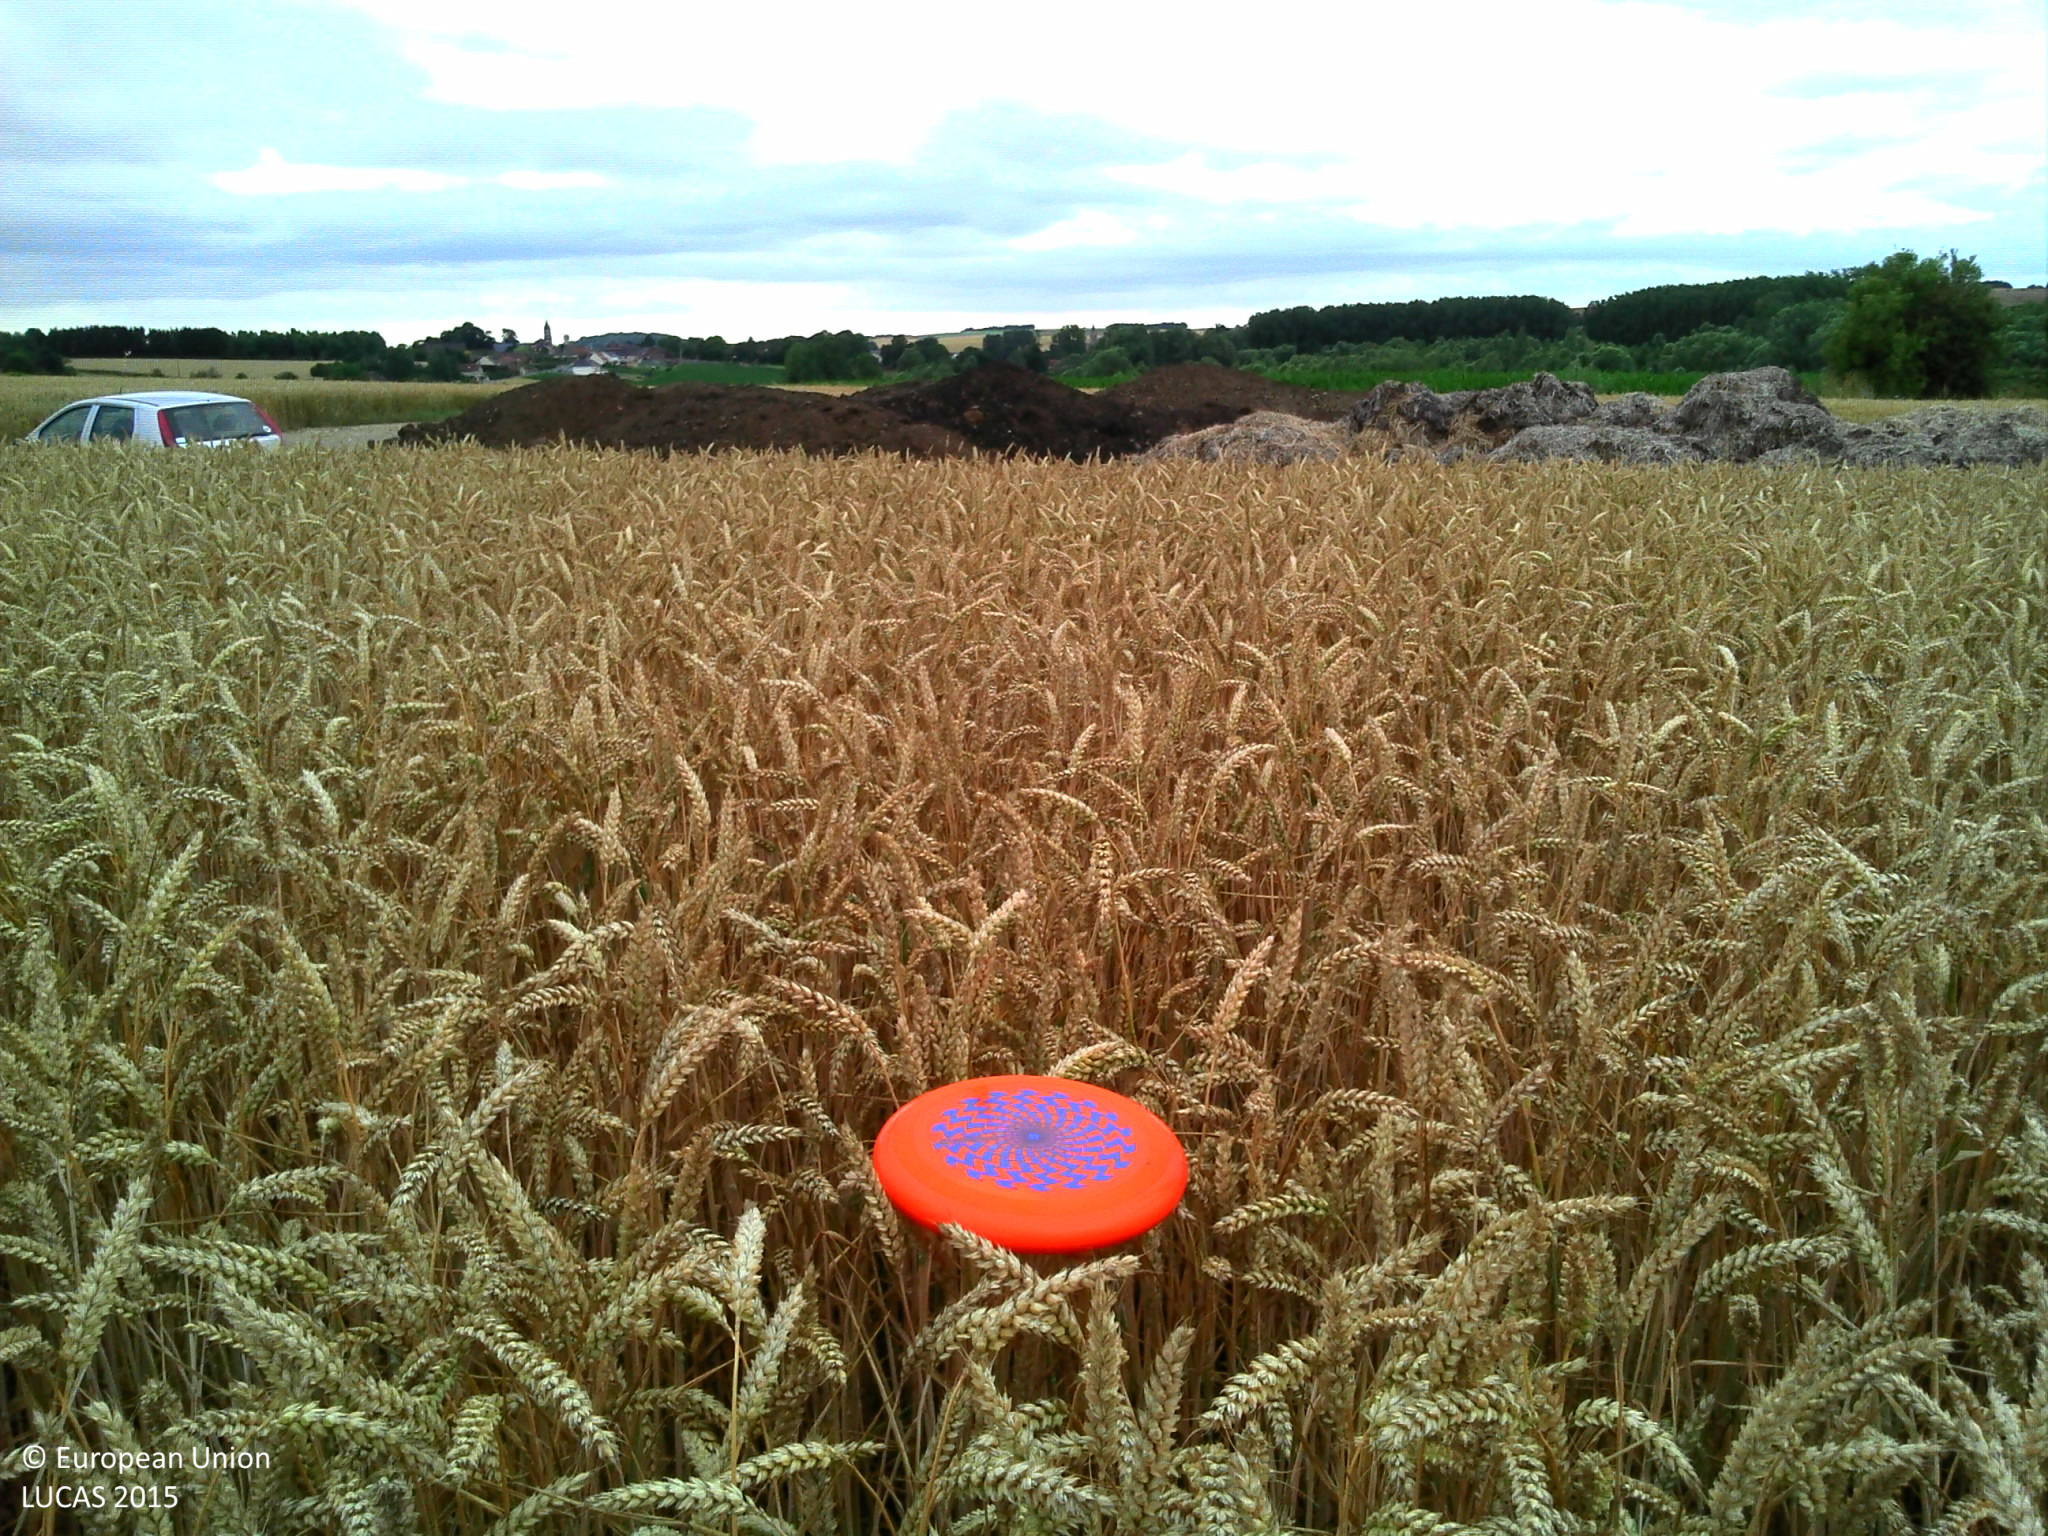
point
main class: Cropland
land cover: Common wheat
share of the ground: > 75 %
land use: Agriculture (excluding fallow land and kitchen gardens)
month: July
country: FR
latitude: 50.0723
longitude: 3.2147
